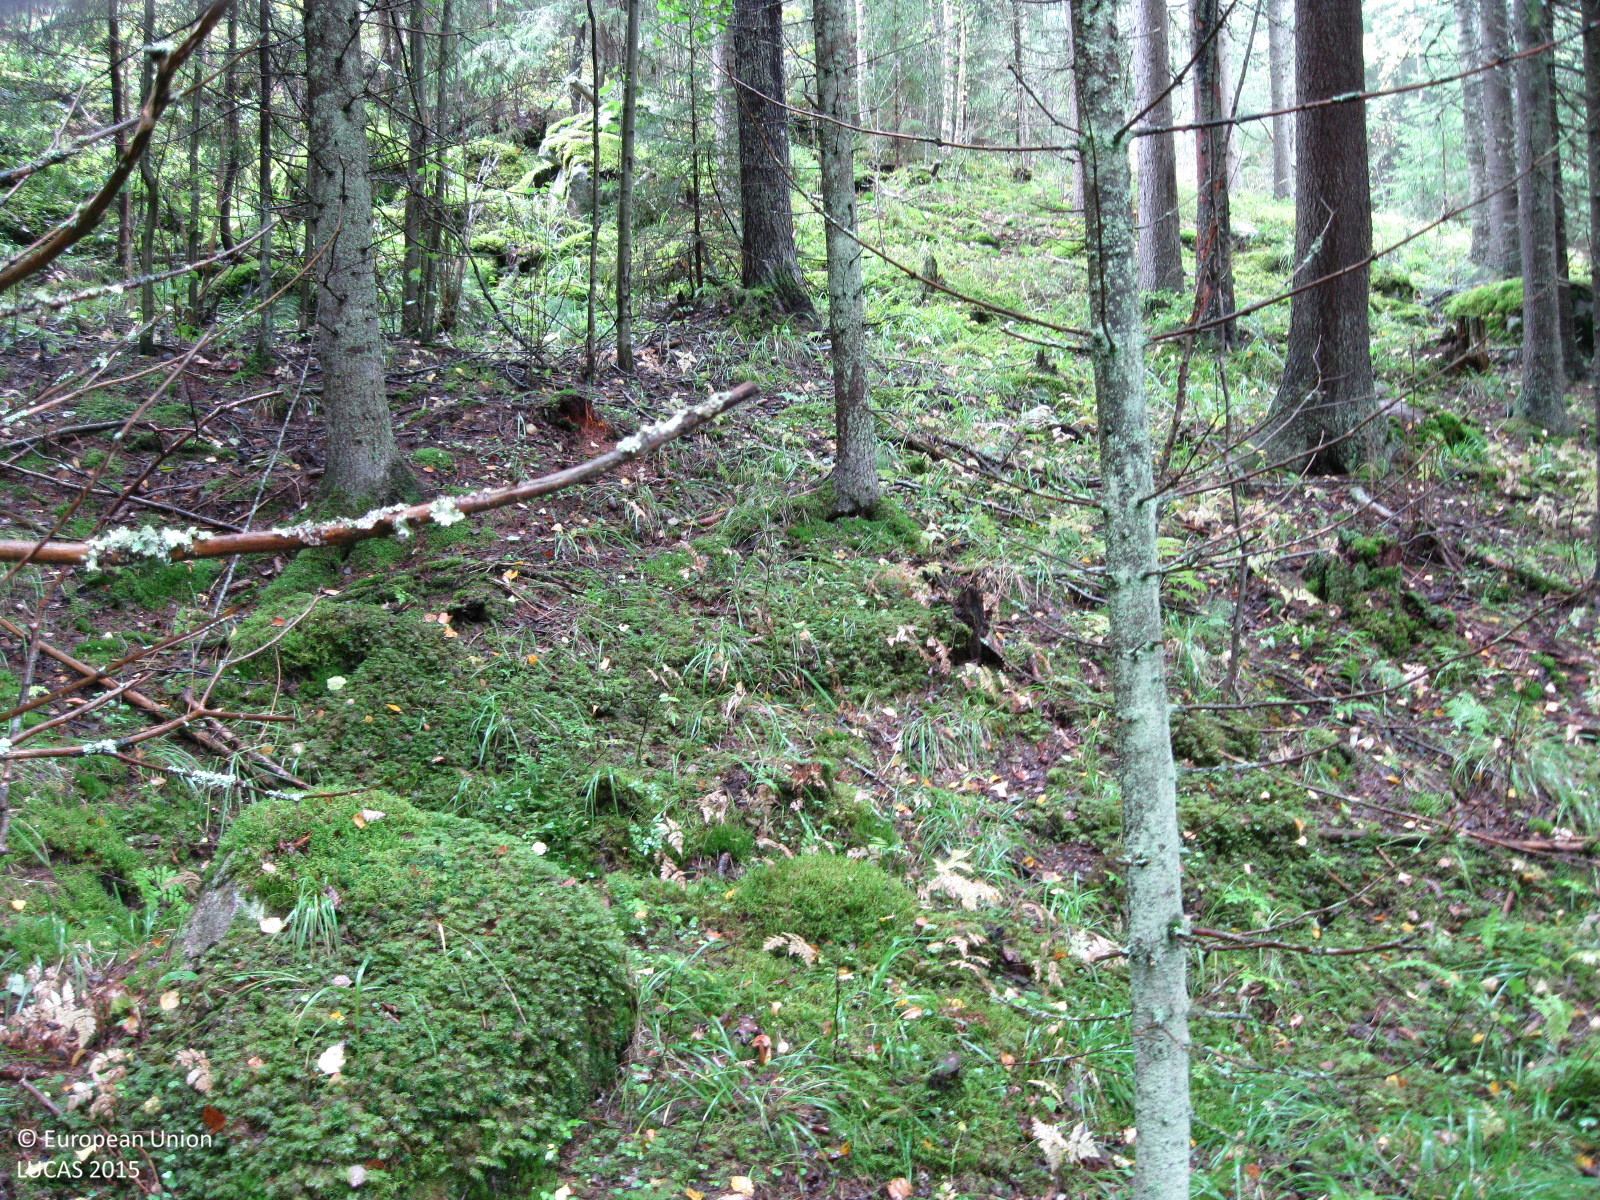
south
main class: Woodland
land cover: Spruce dominated coniferous woodland
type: boreal forest
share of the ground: > 75 %
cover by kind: coniferous forest trees 60 %, broadleaved forest trees 15 %, herbaceous plants 15 %, lichens and mosses 10 %
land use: Forestry
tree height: > 5 m
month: September
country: FI
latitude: 60.8309
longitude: 24.5810
